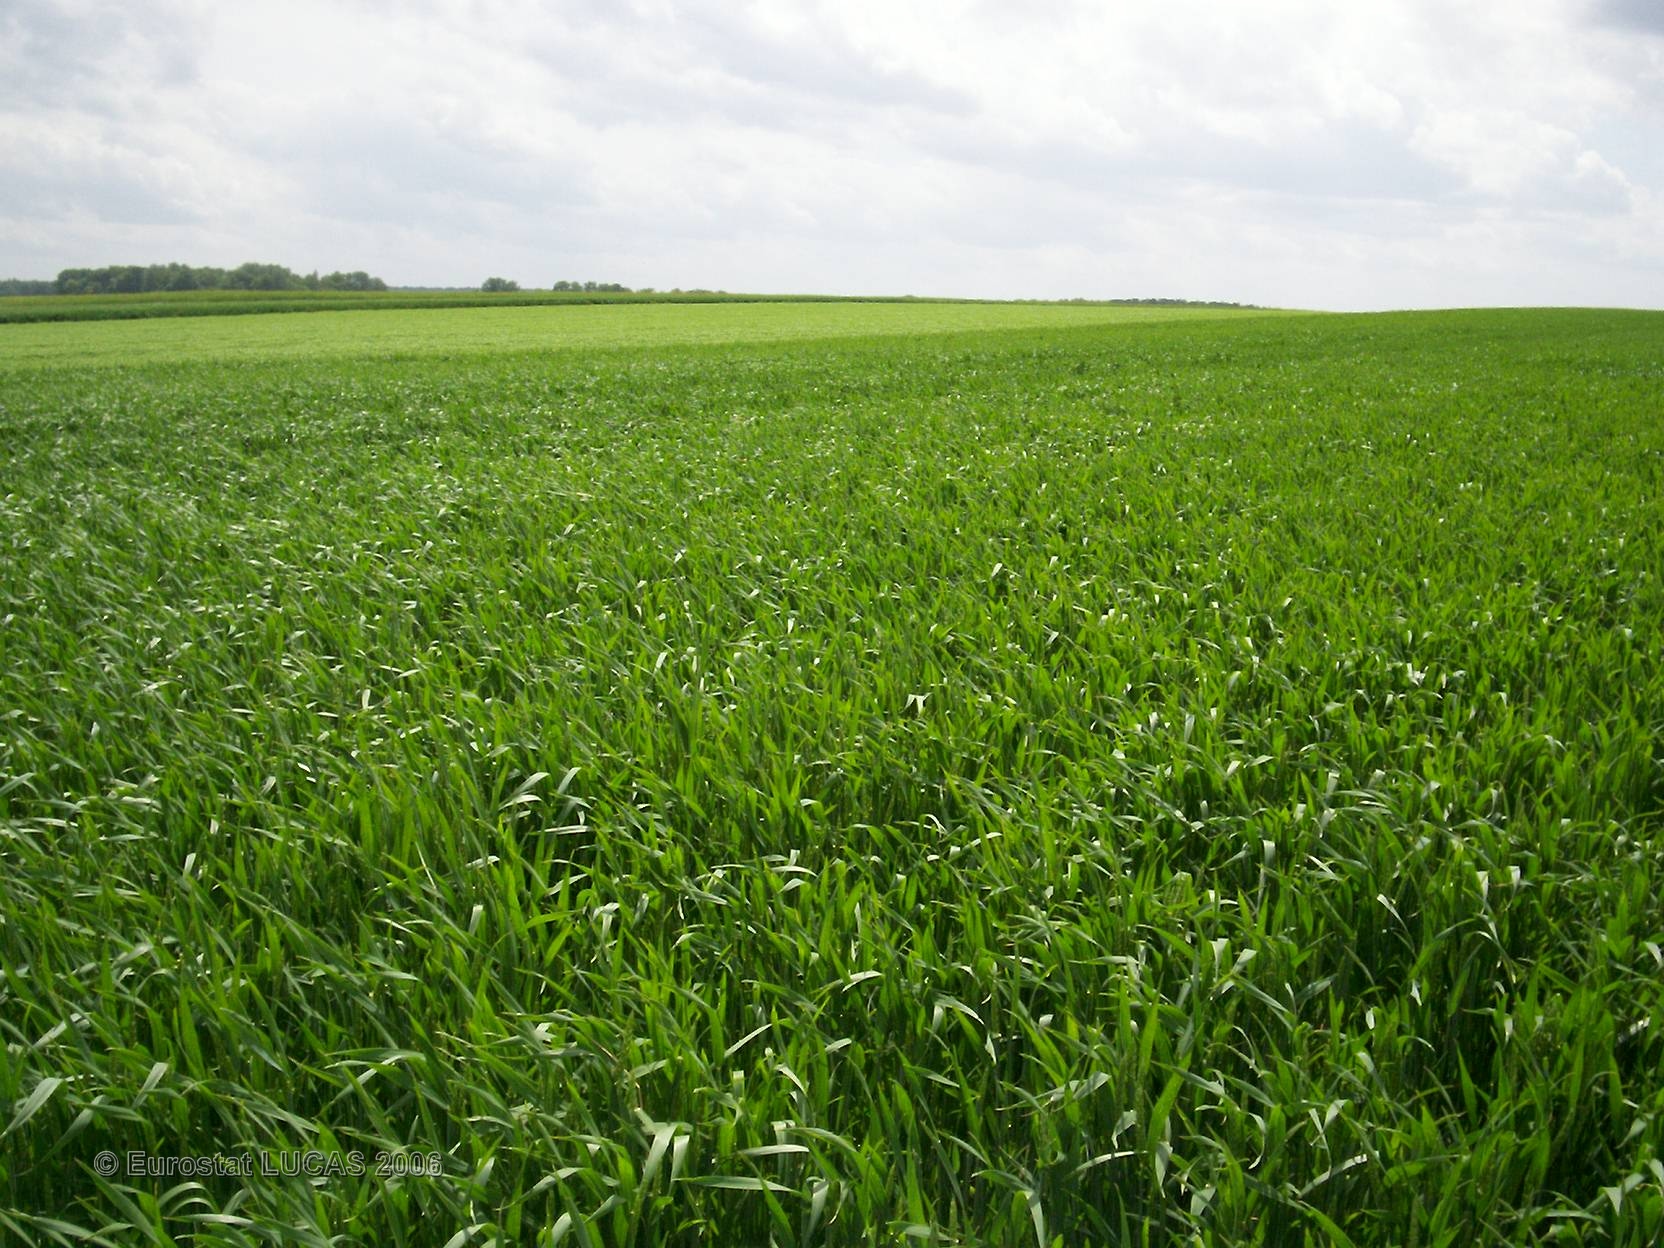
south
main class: Cropland
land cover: Common wheat
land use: Agriculture (excluding fallow land and kitchen gardens)
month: May
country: FR
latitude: 48.3557
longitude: 4.4777
